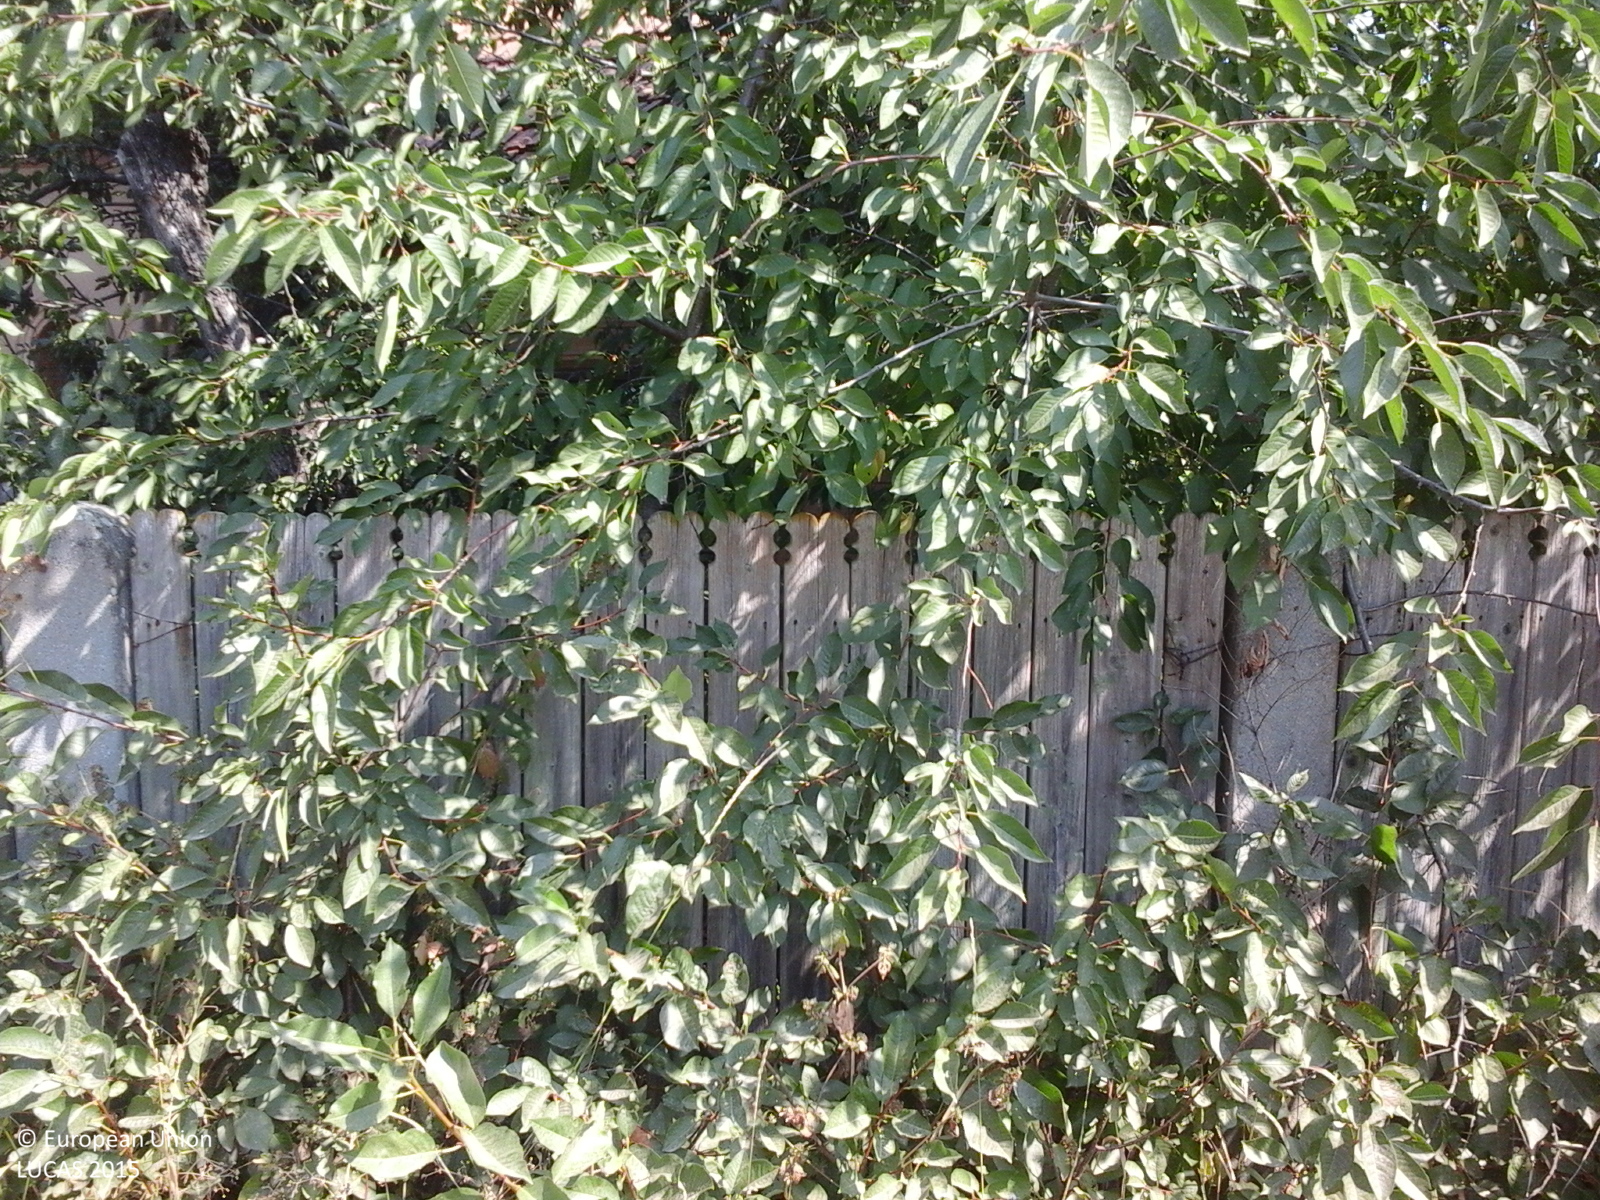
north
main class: Cropland
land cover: Other fruit trees and berries
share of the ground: 50 - 75 %
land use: Kitchen garden
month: August
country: RO
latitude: 44.3820
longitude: 23.0361
